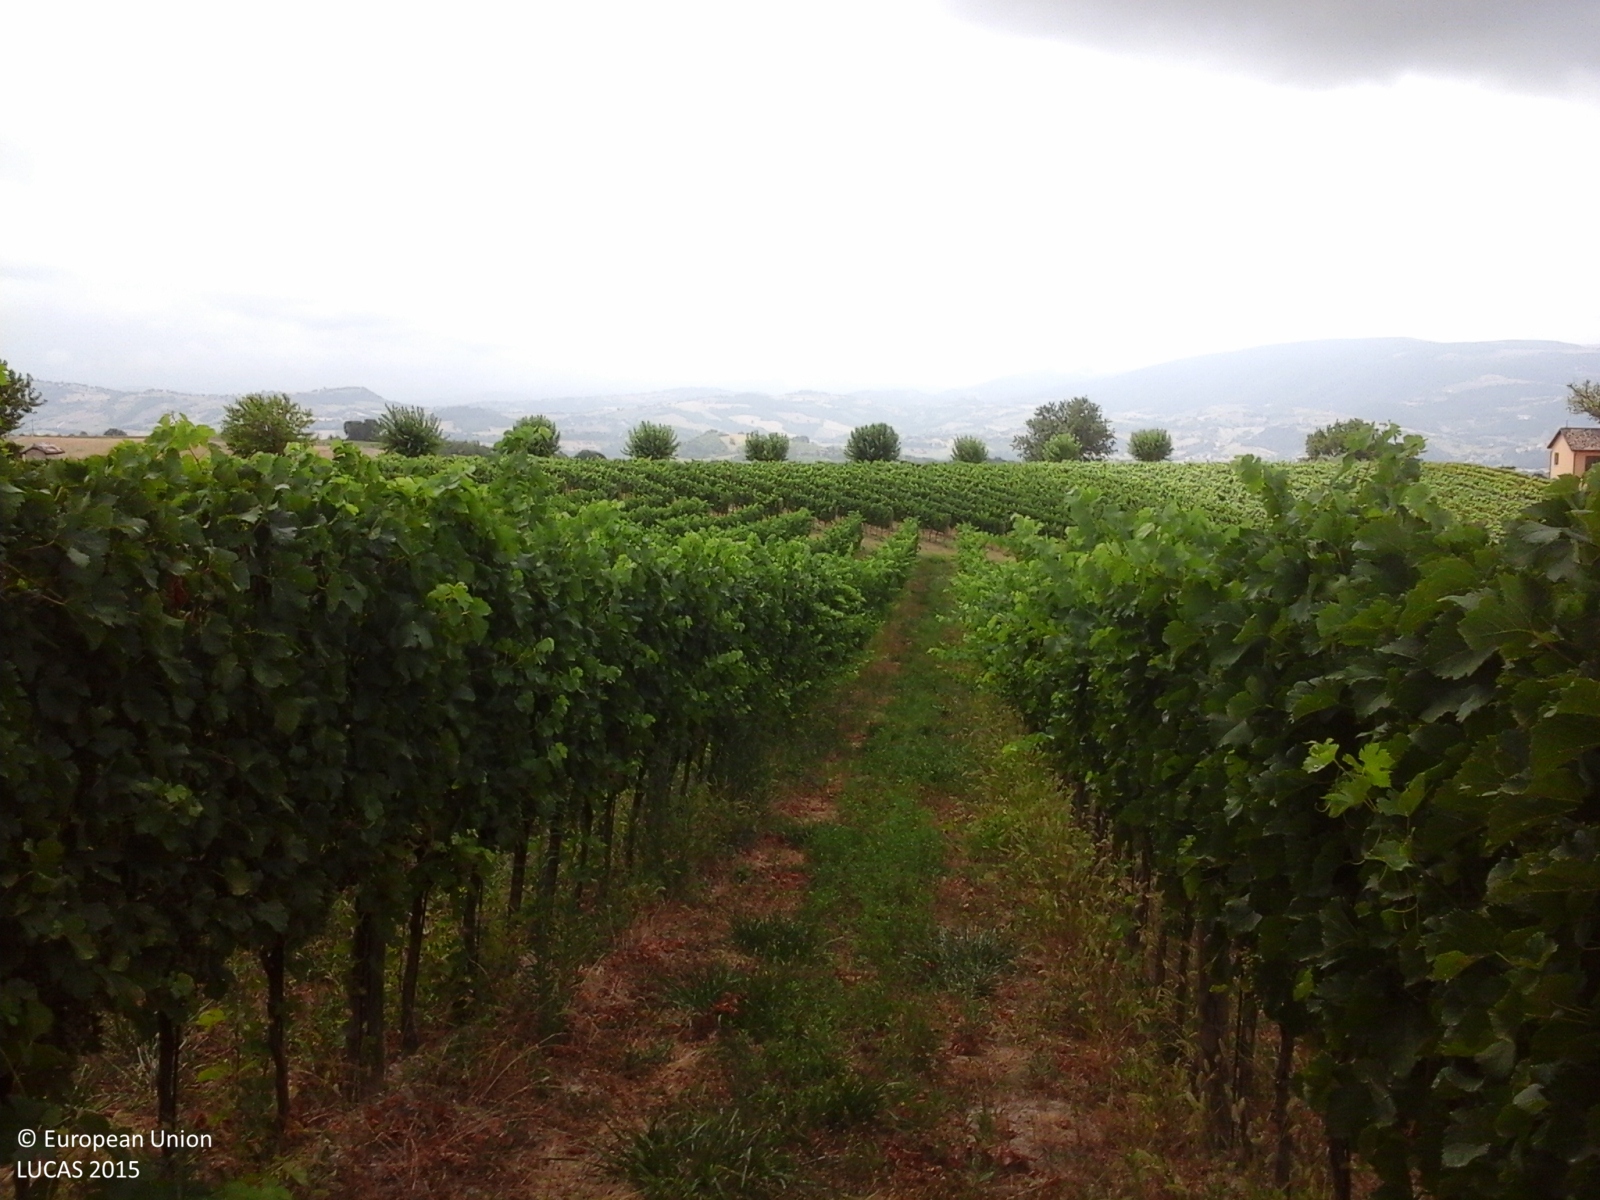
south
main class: Cropland
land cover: Vineyards
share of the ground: 50 - 75 %
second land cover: Spontaneously vegetated surfaces
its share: 50 - 75 %
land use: Agriculture (excluding fallow land and kitchen gardens)
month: July
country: IT
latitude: 43.2718
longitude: 13.2074
